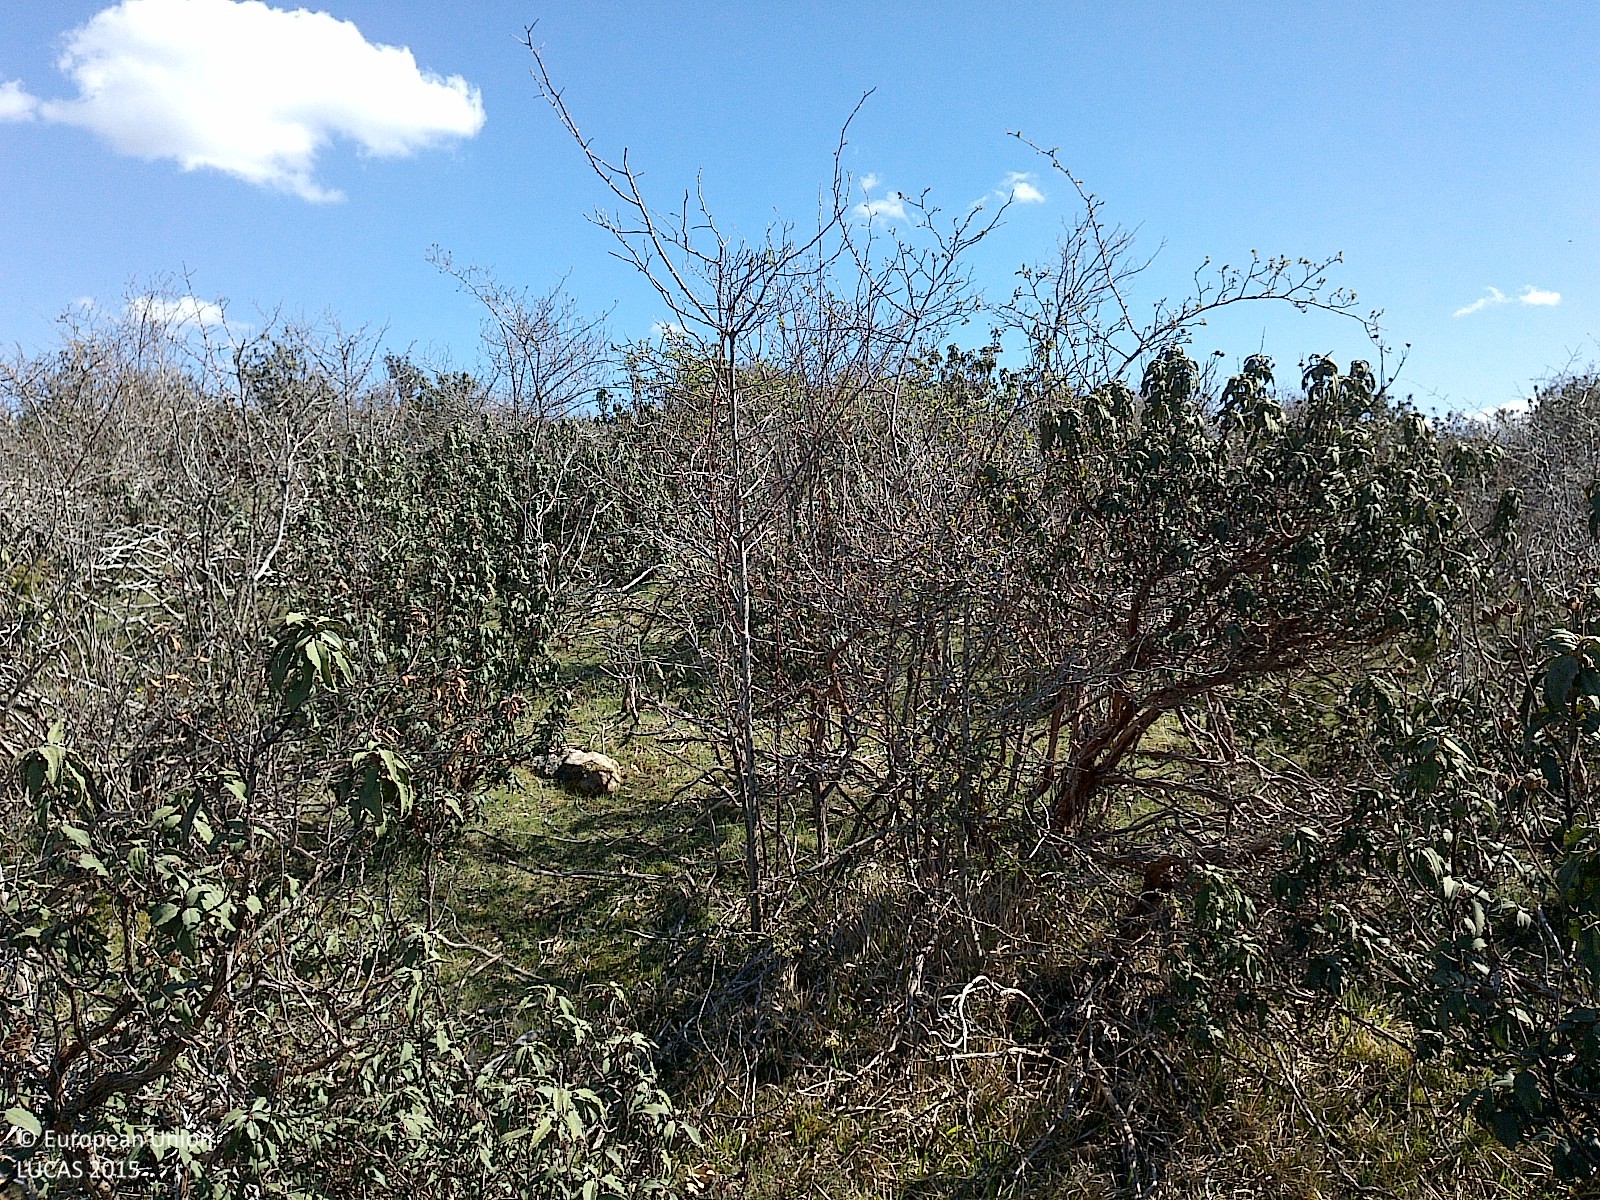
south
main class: Shrubland
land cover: Shrubland with sparse tree cover
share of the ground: > 75 %
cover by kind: shrubs 80 %, herbaceous plants 15 %, broadleaved forest trees 5 %
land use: Agriculture (excluding fallow land and kitchen gardens)
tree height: < 5 m
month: April
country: ES
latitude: 42.0943
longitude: -3.2176
